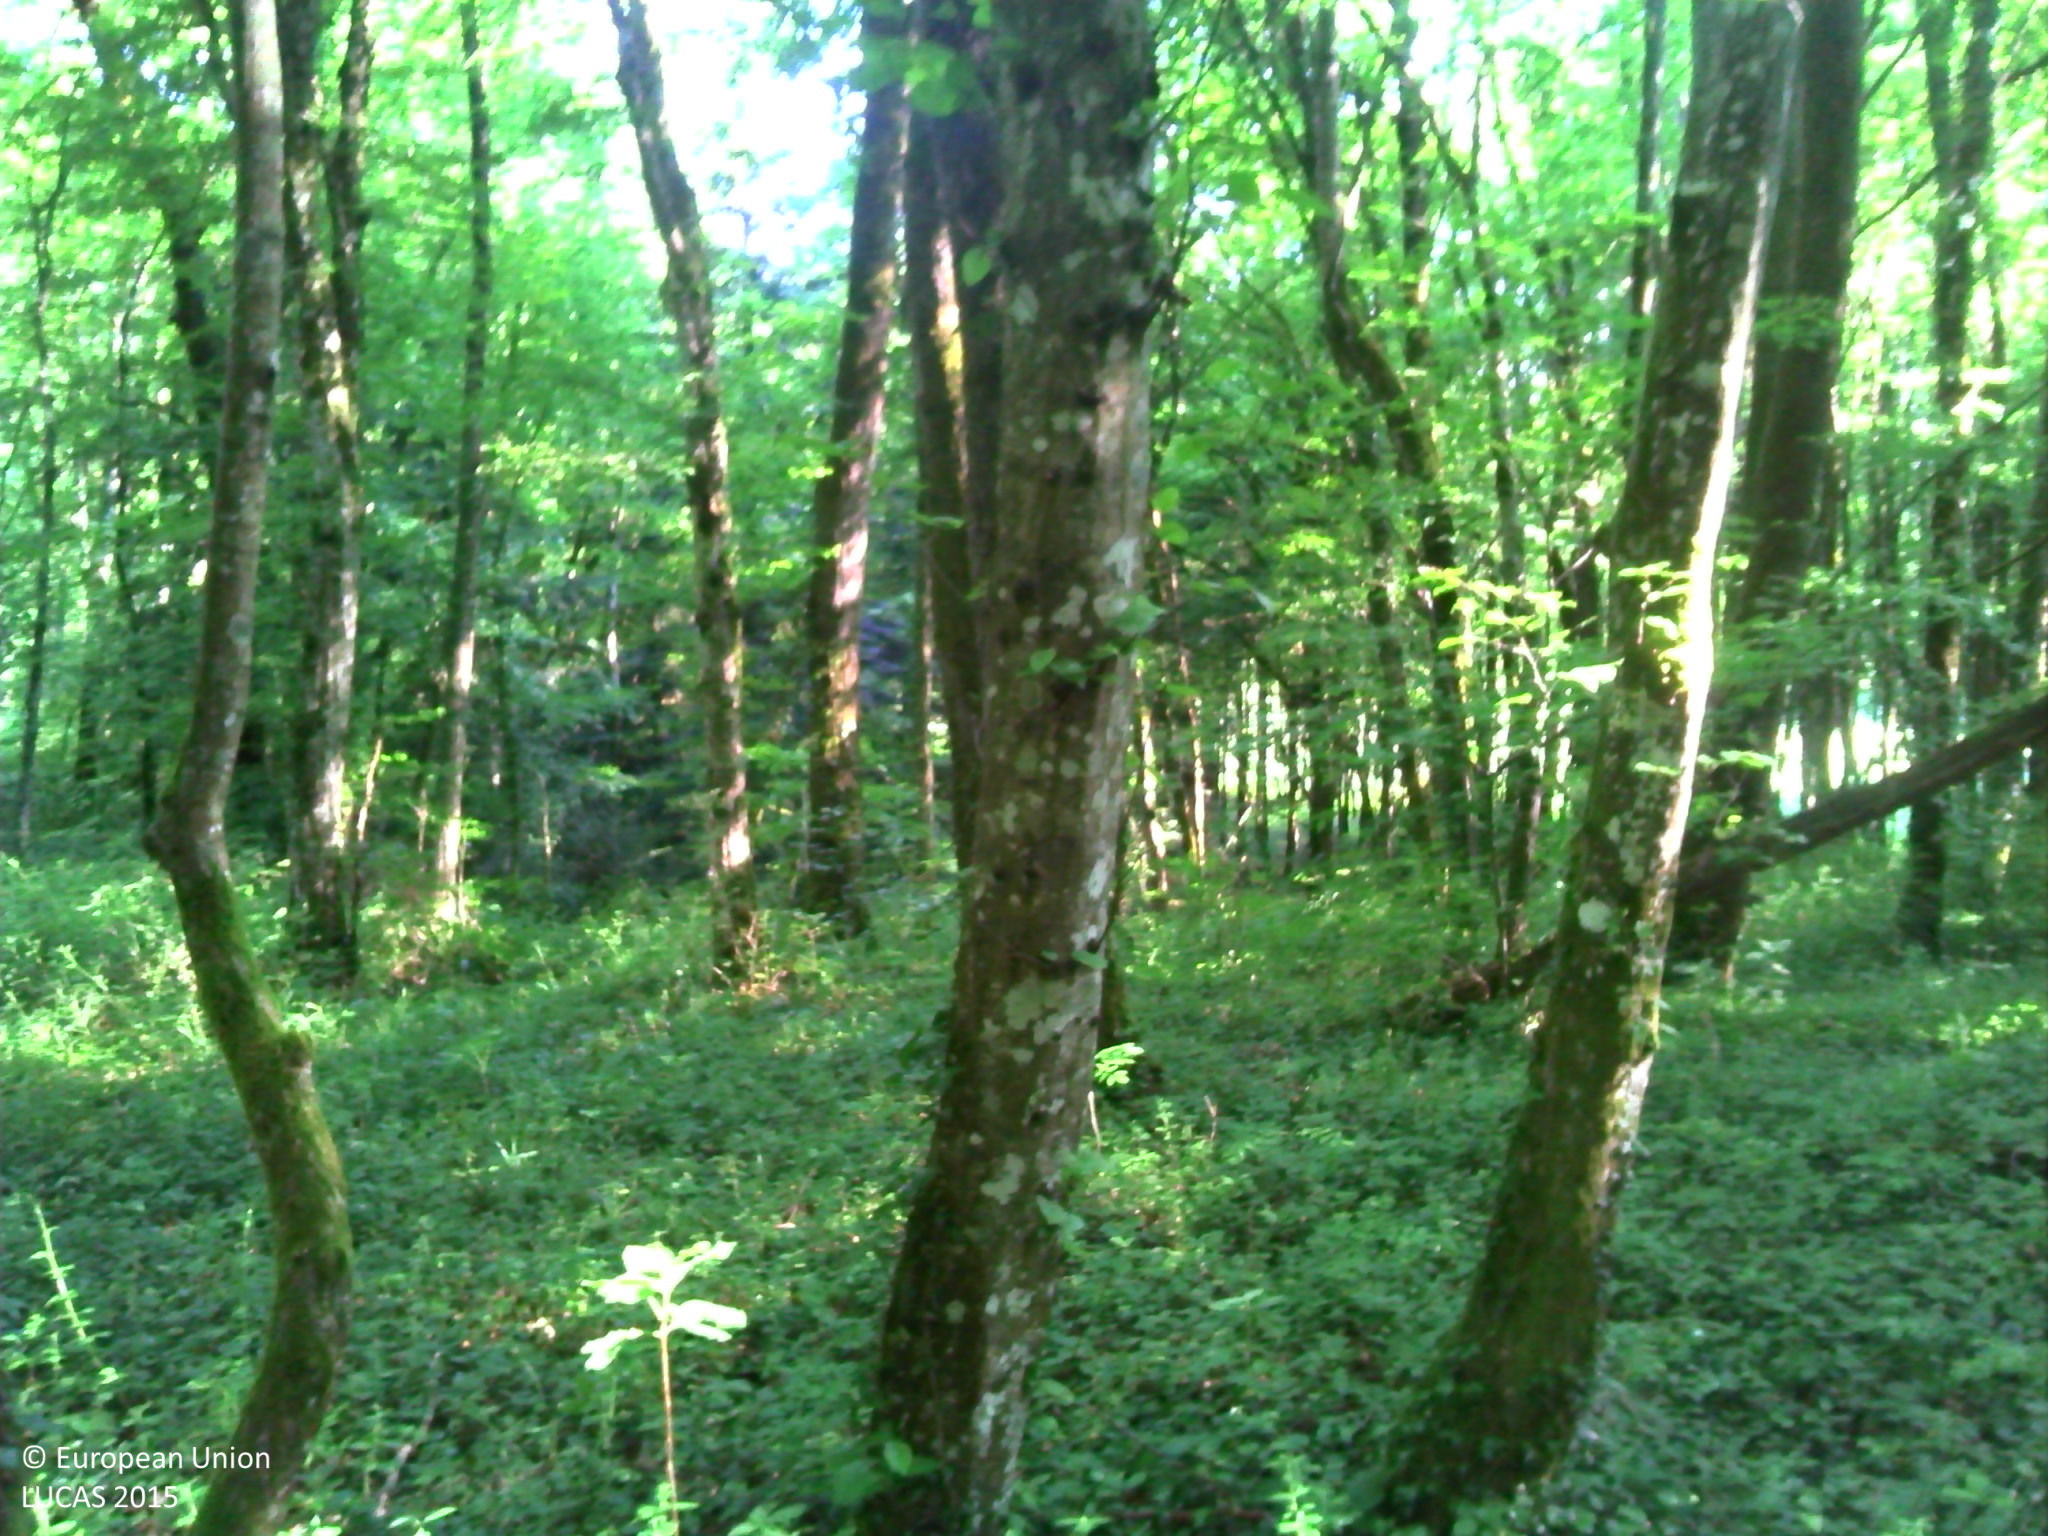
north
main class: Woodland
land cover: Broadleaved woodland
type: beech forest
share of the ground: > 75 %
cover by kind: broadleaved forest trees 95 %, herbaceous plants 5 %
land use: Forestry
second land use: Sport
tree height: > 5 m
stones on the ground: < 10 %
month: June
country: FR
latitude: 47.5981
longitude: 6.1576
